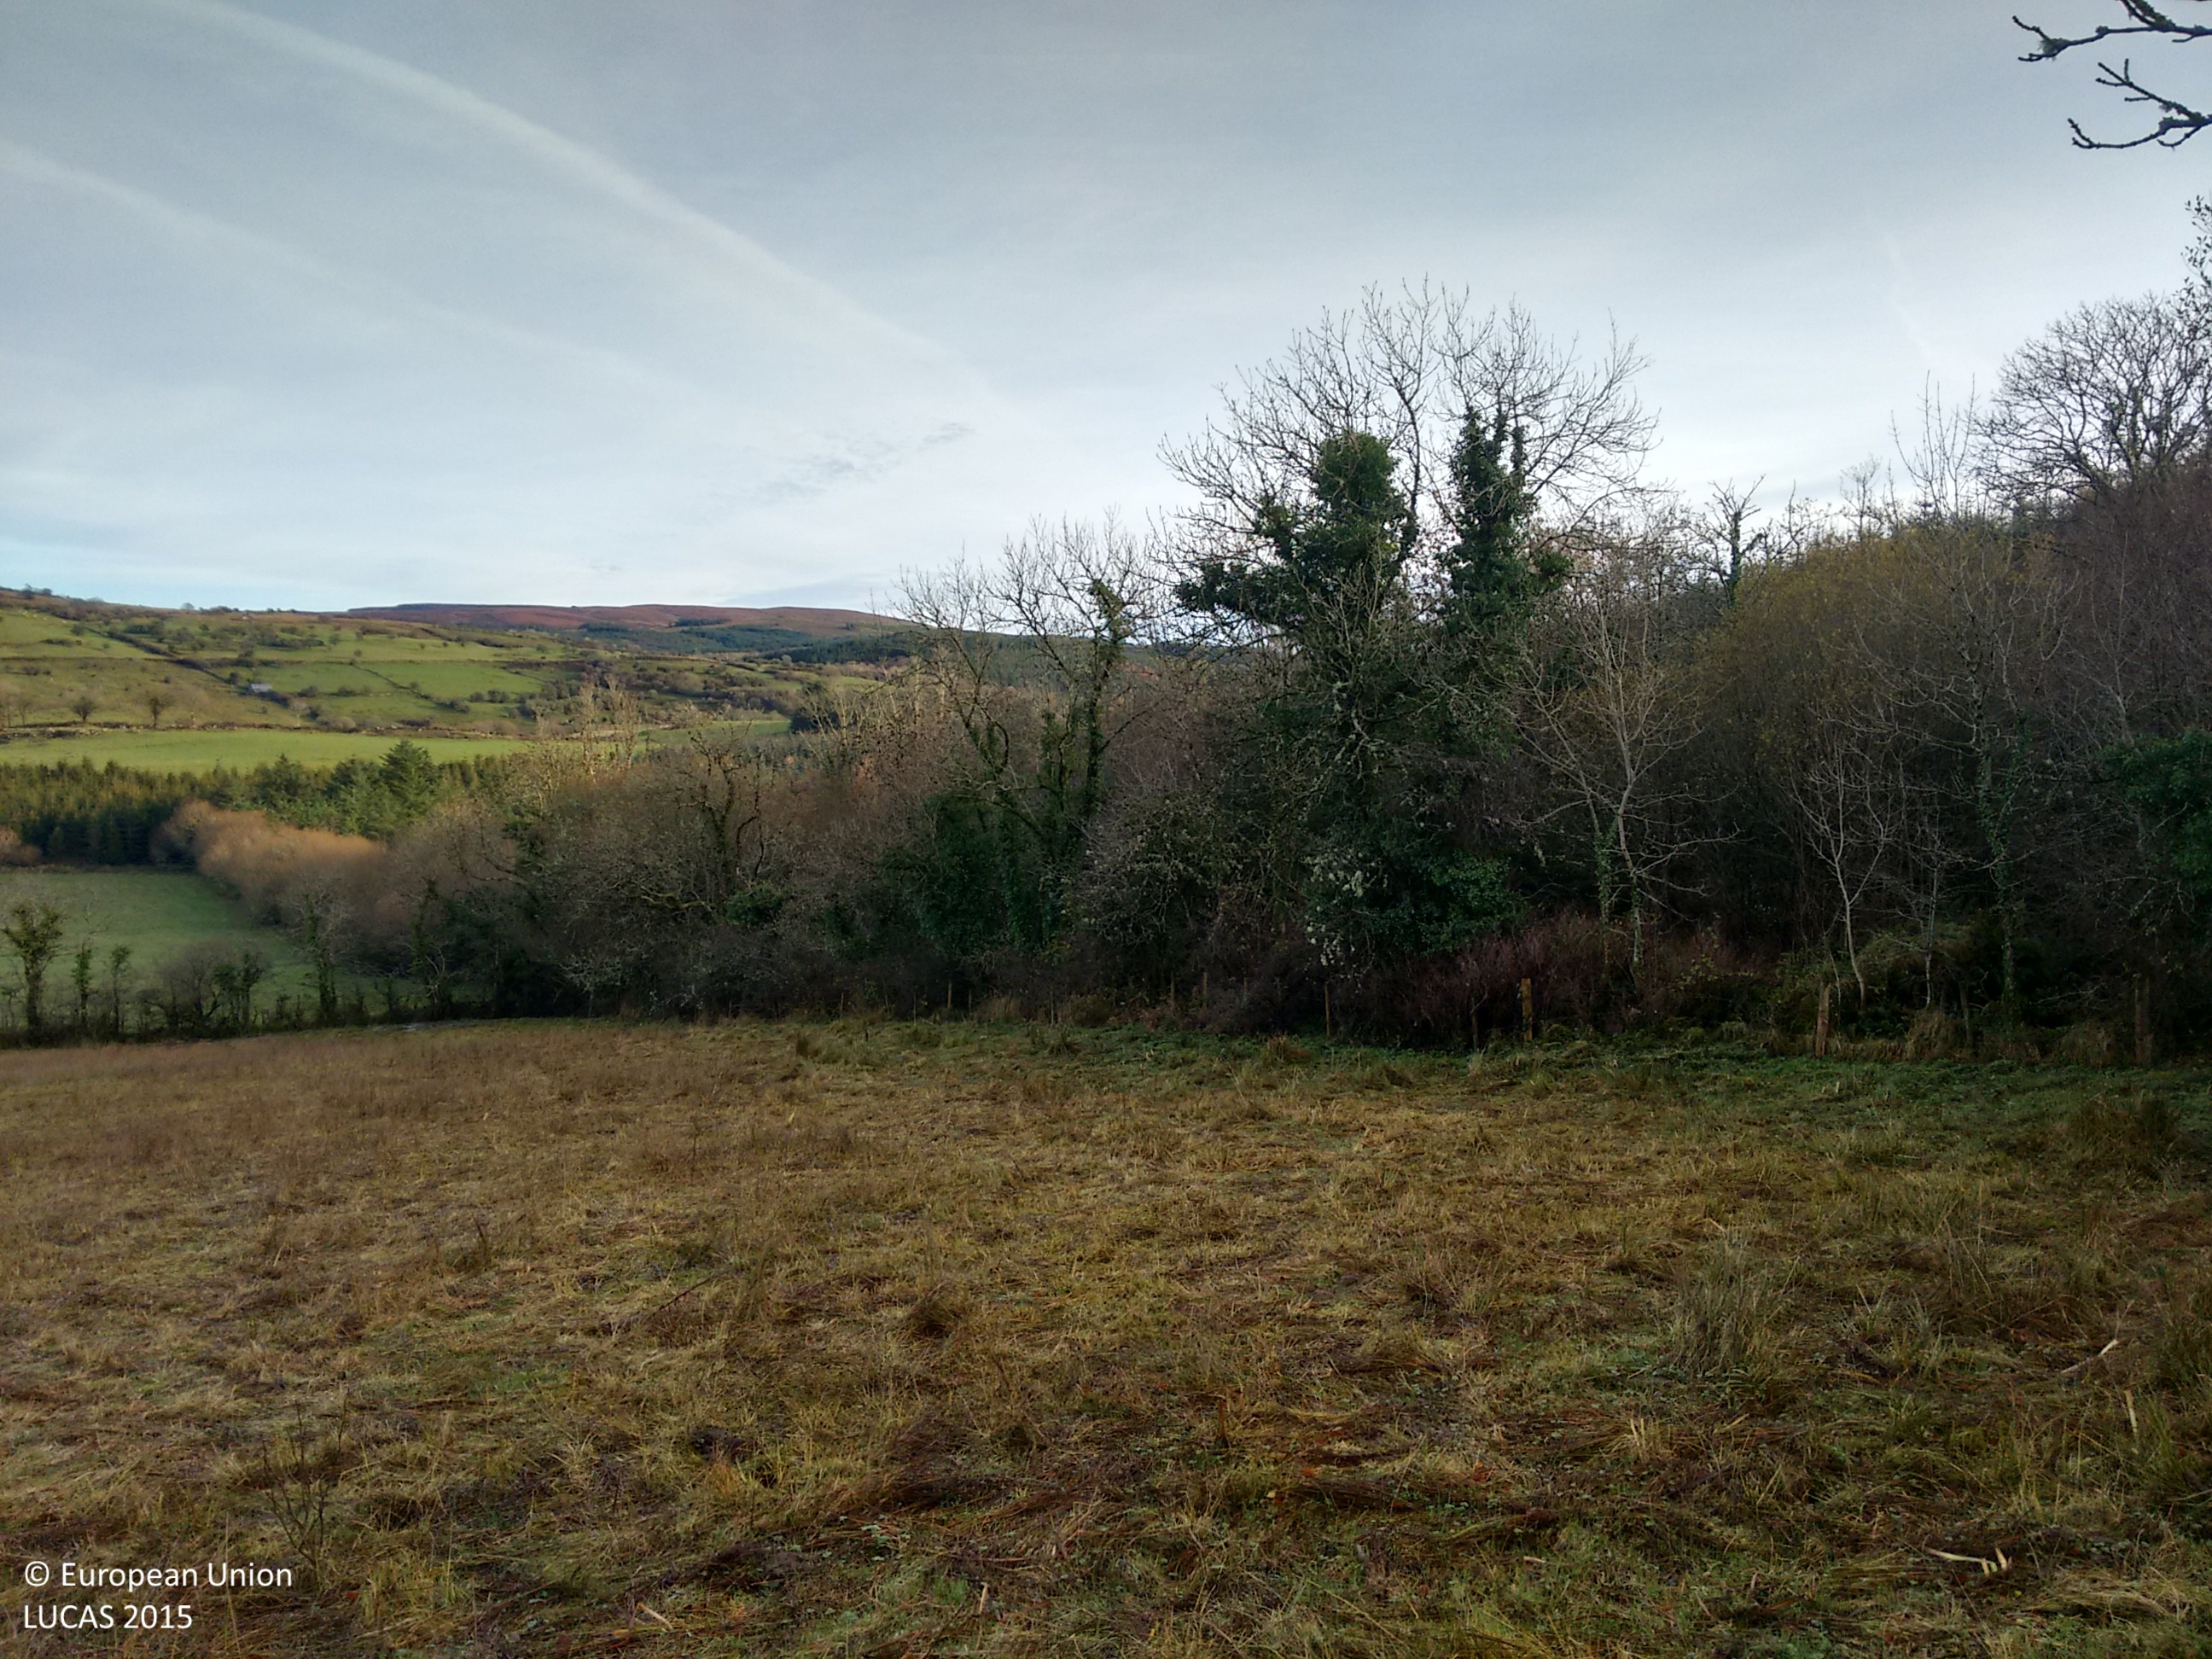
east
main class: Woodland
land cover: Broadleaved woodland
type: exotic forest
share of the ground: > 75 %
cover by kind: broadleaved forest trees 95 %, coniferous forest trees 5 %
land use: Forestry
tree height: > 5 m
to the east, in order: Broadleaved woodland; Spruce dominated coniferous woodland
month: November
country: IE
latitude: 54.2386
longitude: -8.2098
